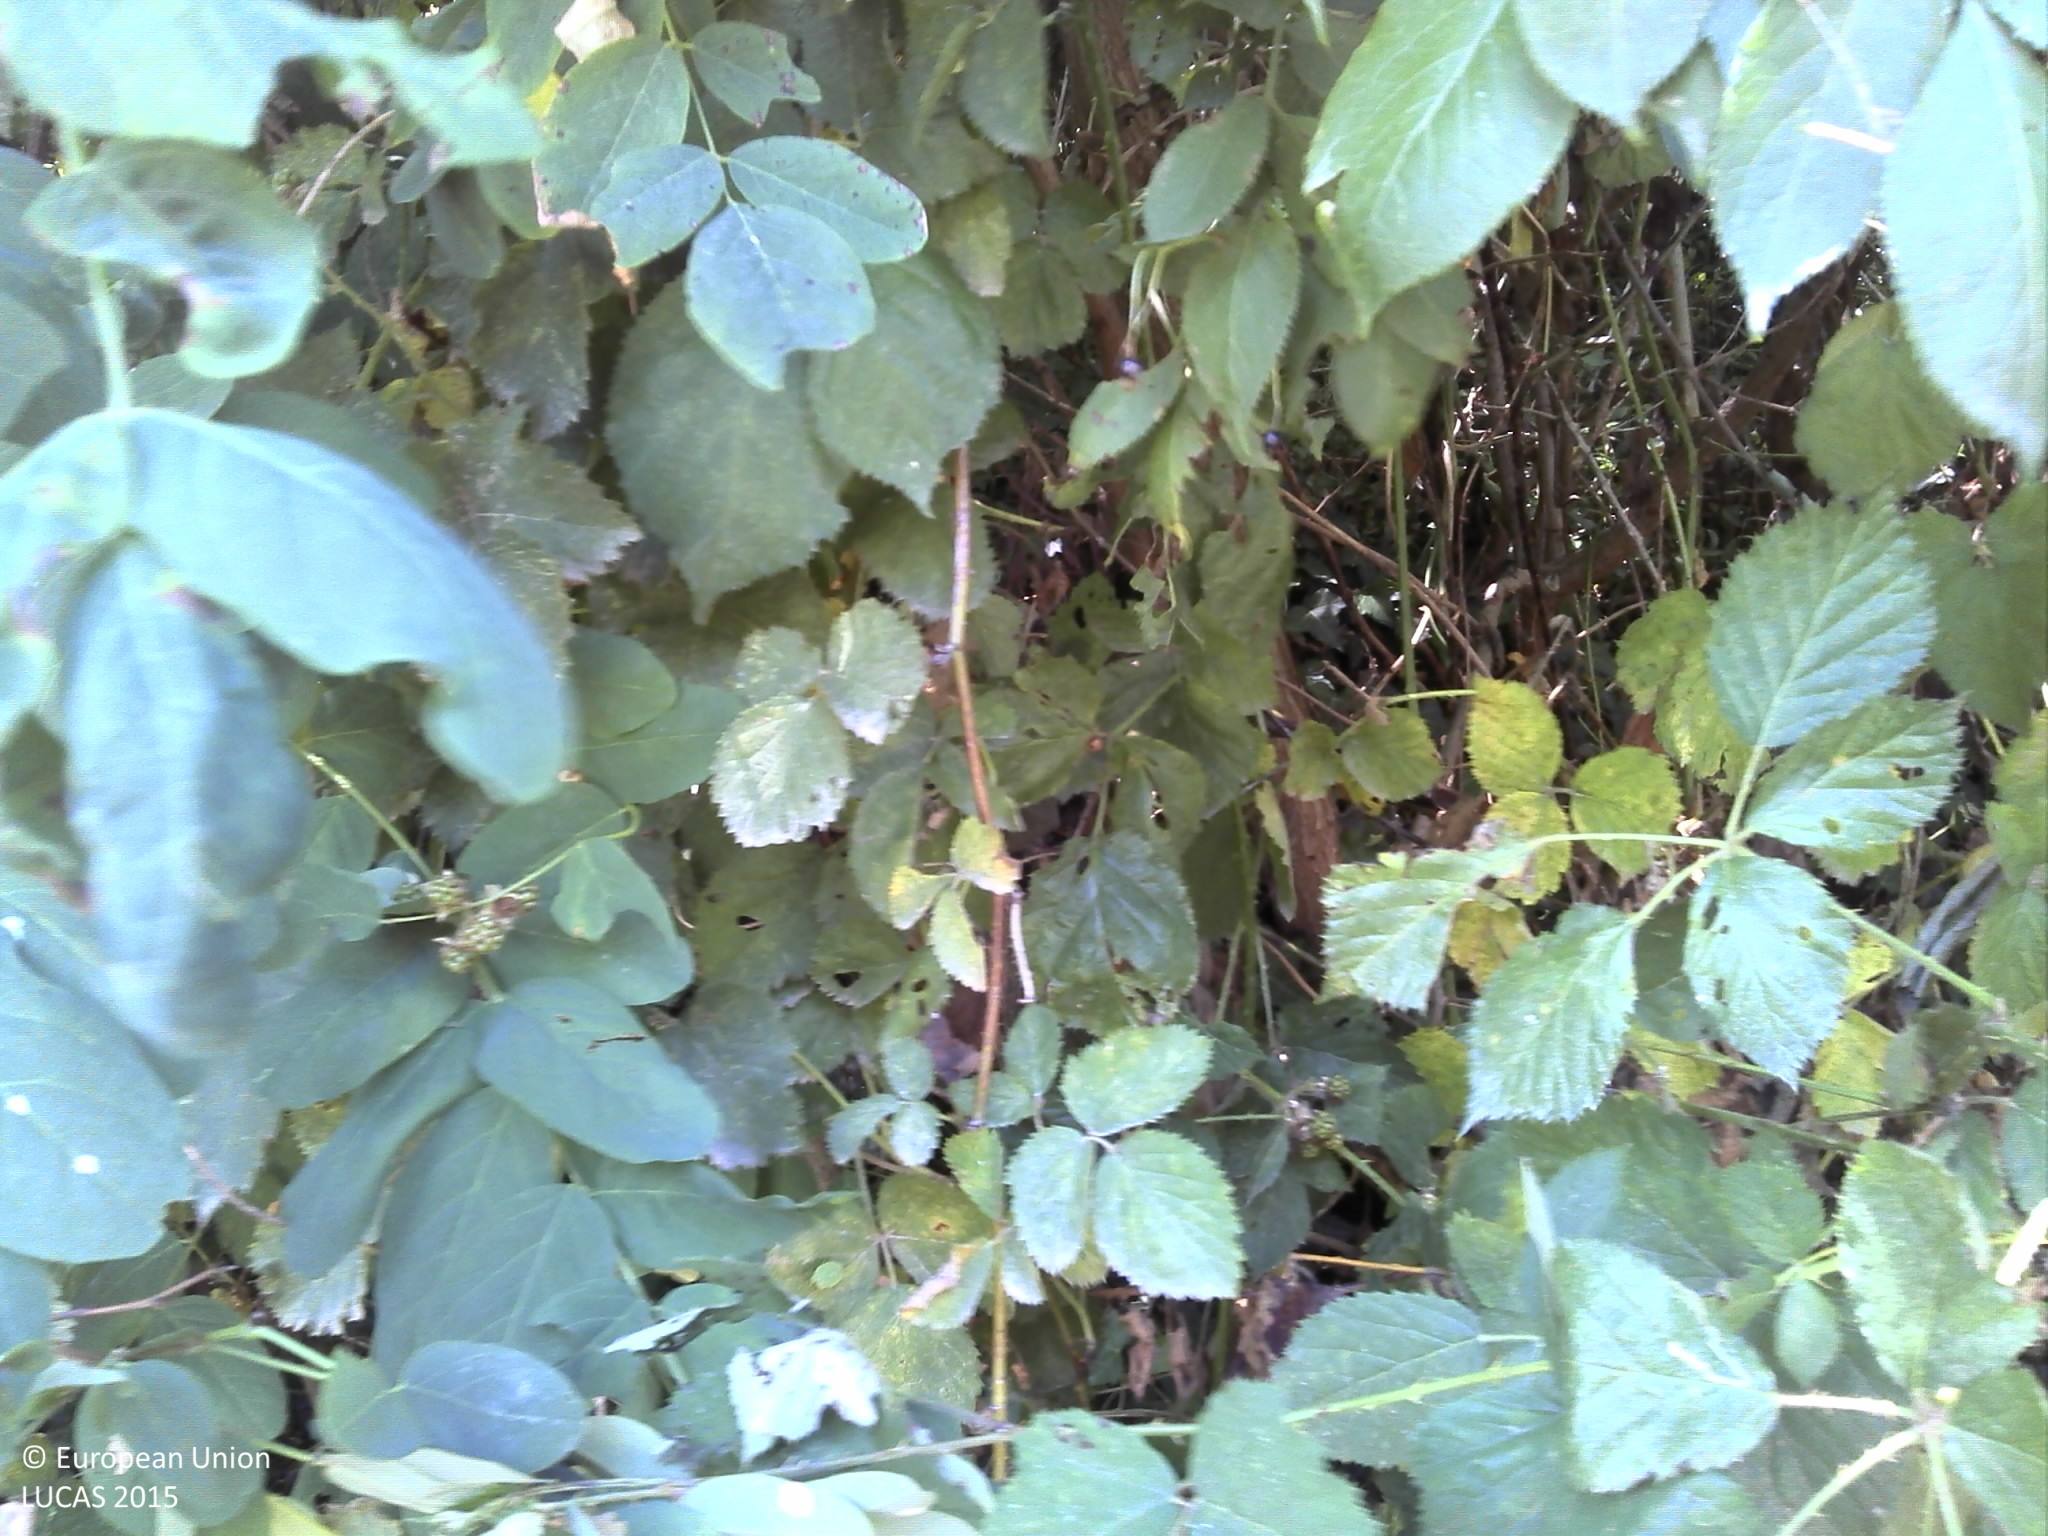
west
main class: Shrubland
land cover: Shrubland with sparse tree cover
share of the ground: > 75 %
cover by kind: shrubs 95 %, broadleaved forest trees 5 %
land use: Semi-natural and natural areas not in use
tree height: < 5 m
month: July
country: HR
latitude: 45.4632
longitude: 16.8413
